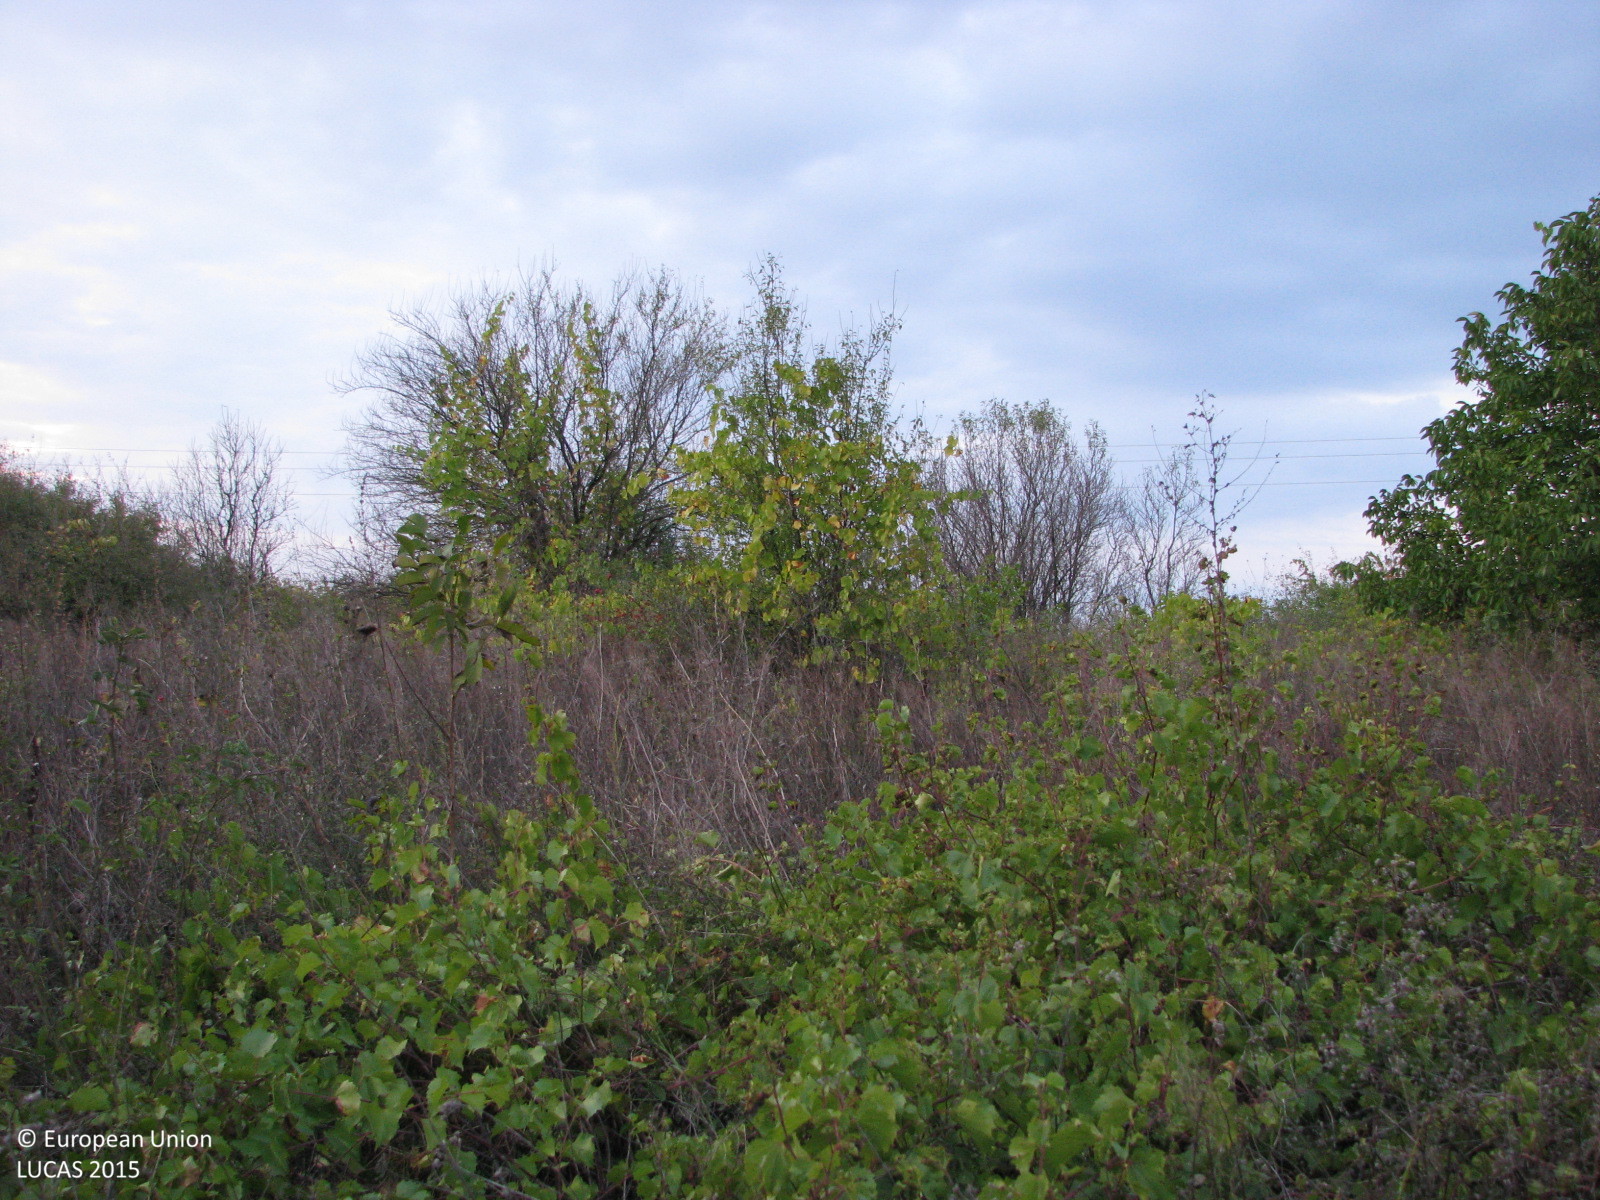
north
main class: Shrubland
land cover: Shrubland with sparse tree cover
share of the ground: 50 - 75 %
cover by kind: shrubs 60 %, herbaceous plants 35 %, broadleaved forest trees 5 %
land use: Semi-natural and natural areas not in use
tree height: < 5 m
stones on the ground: < 10 %
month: October
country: BG
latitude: 42.2524
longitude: 26.4634
